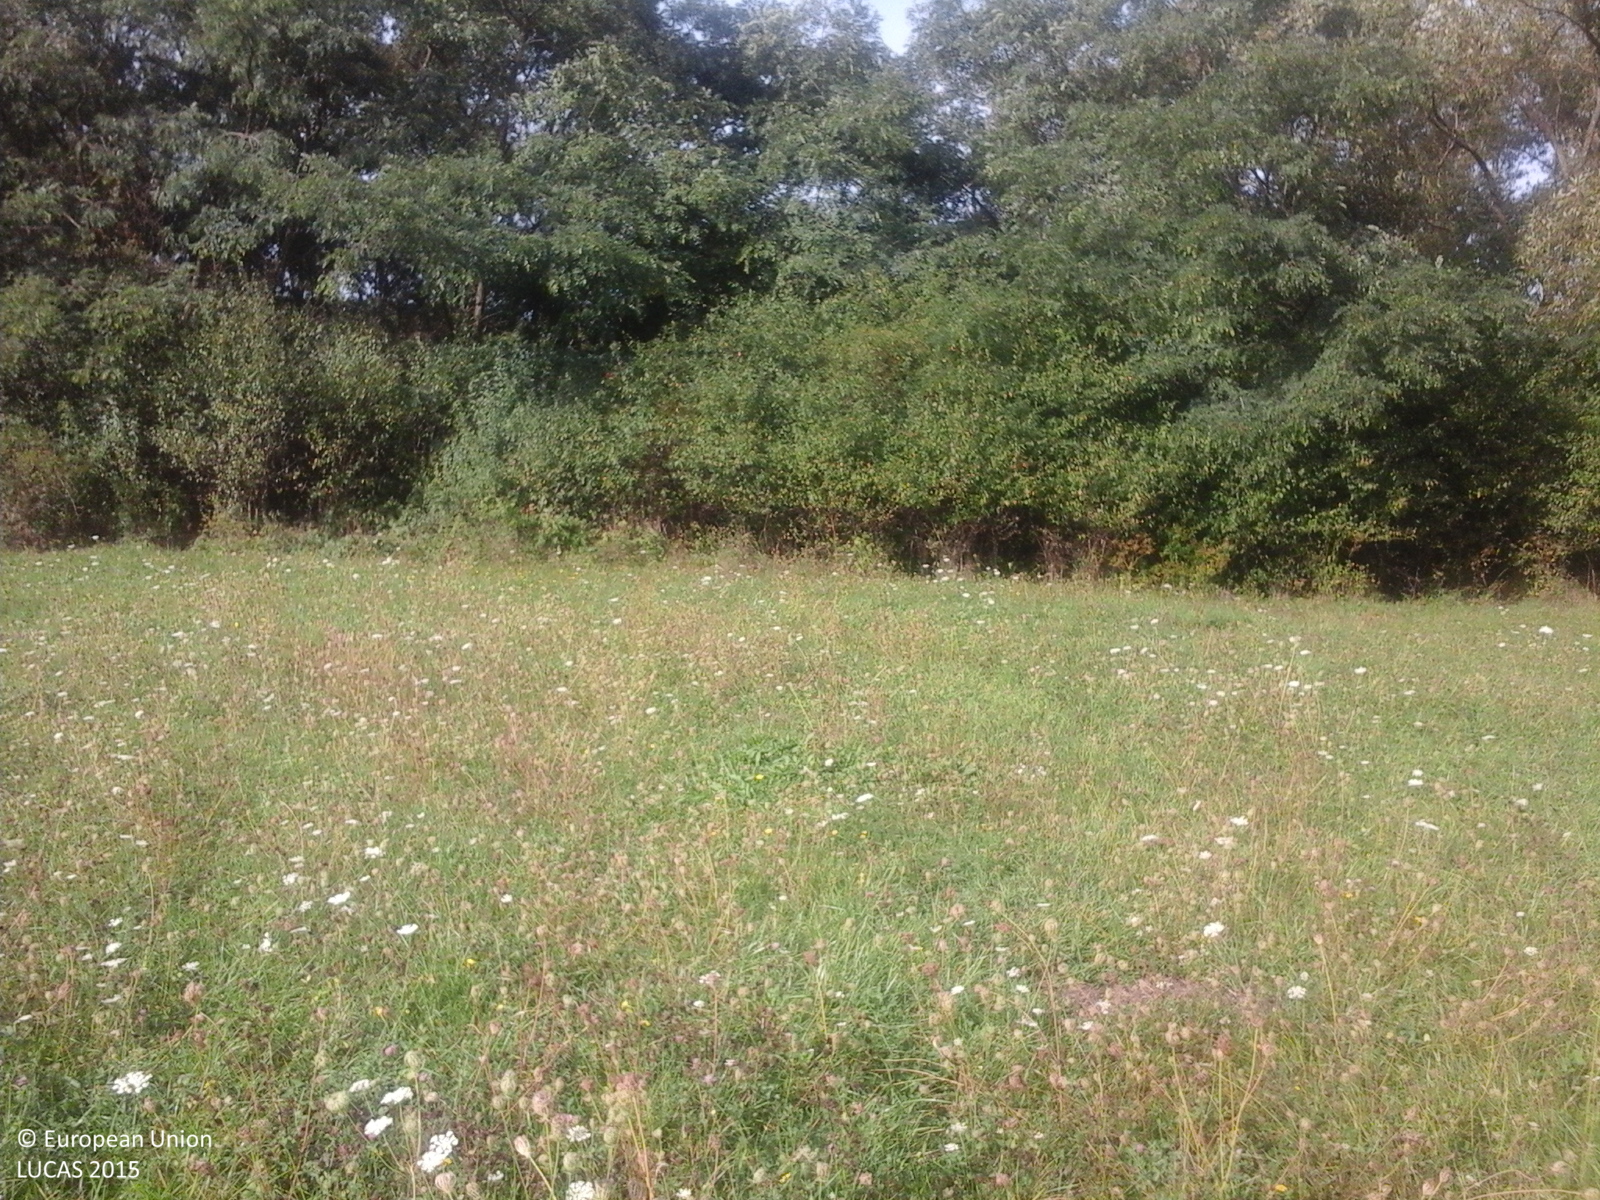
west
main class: Grassland
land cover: Grassland without tree/shrub cover
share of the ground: > 75 %
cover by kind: herbaceous plants 100 %
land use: Agriculture (excluding fallow land and kitchen gardens)
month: September
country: RO
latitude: 46.9509
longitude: 23.3516
